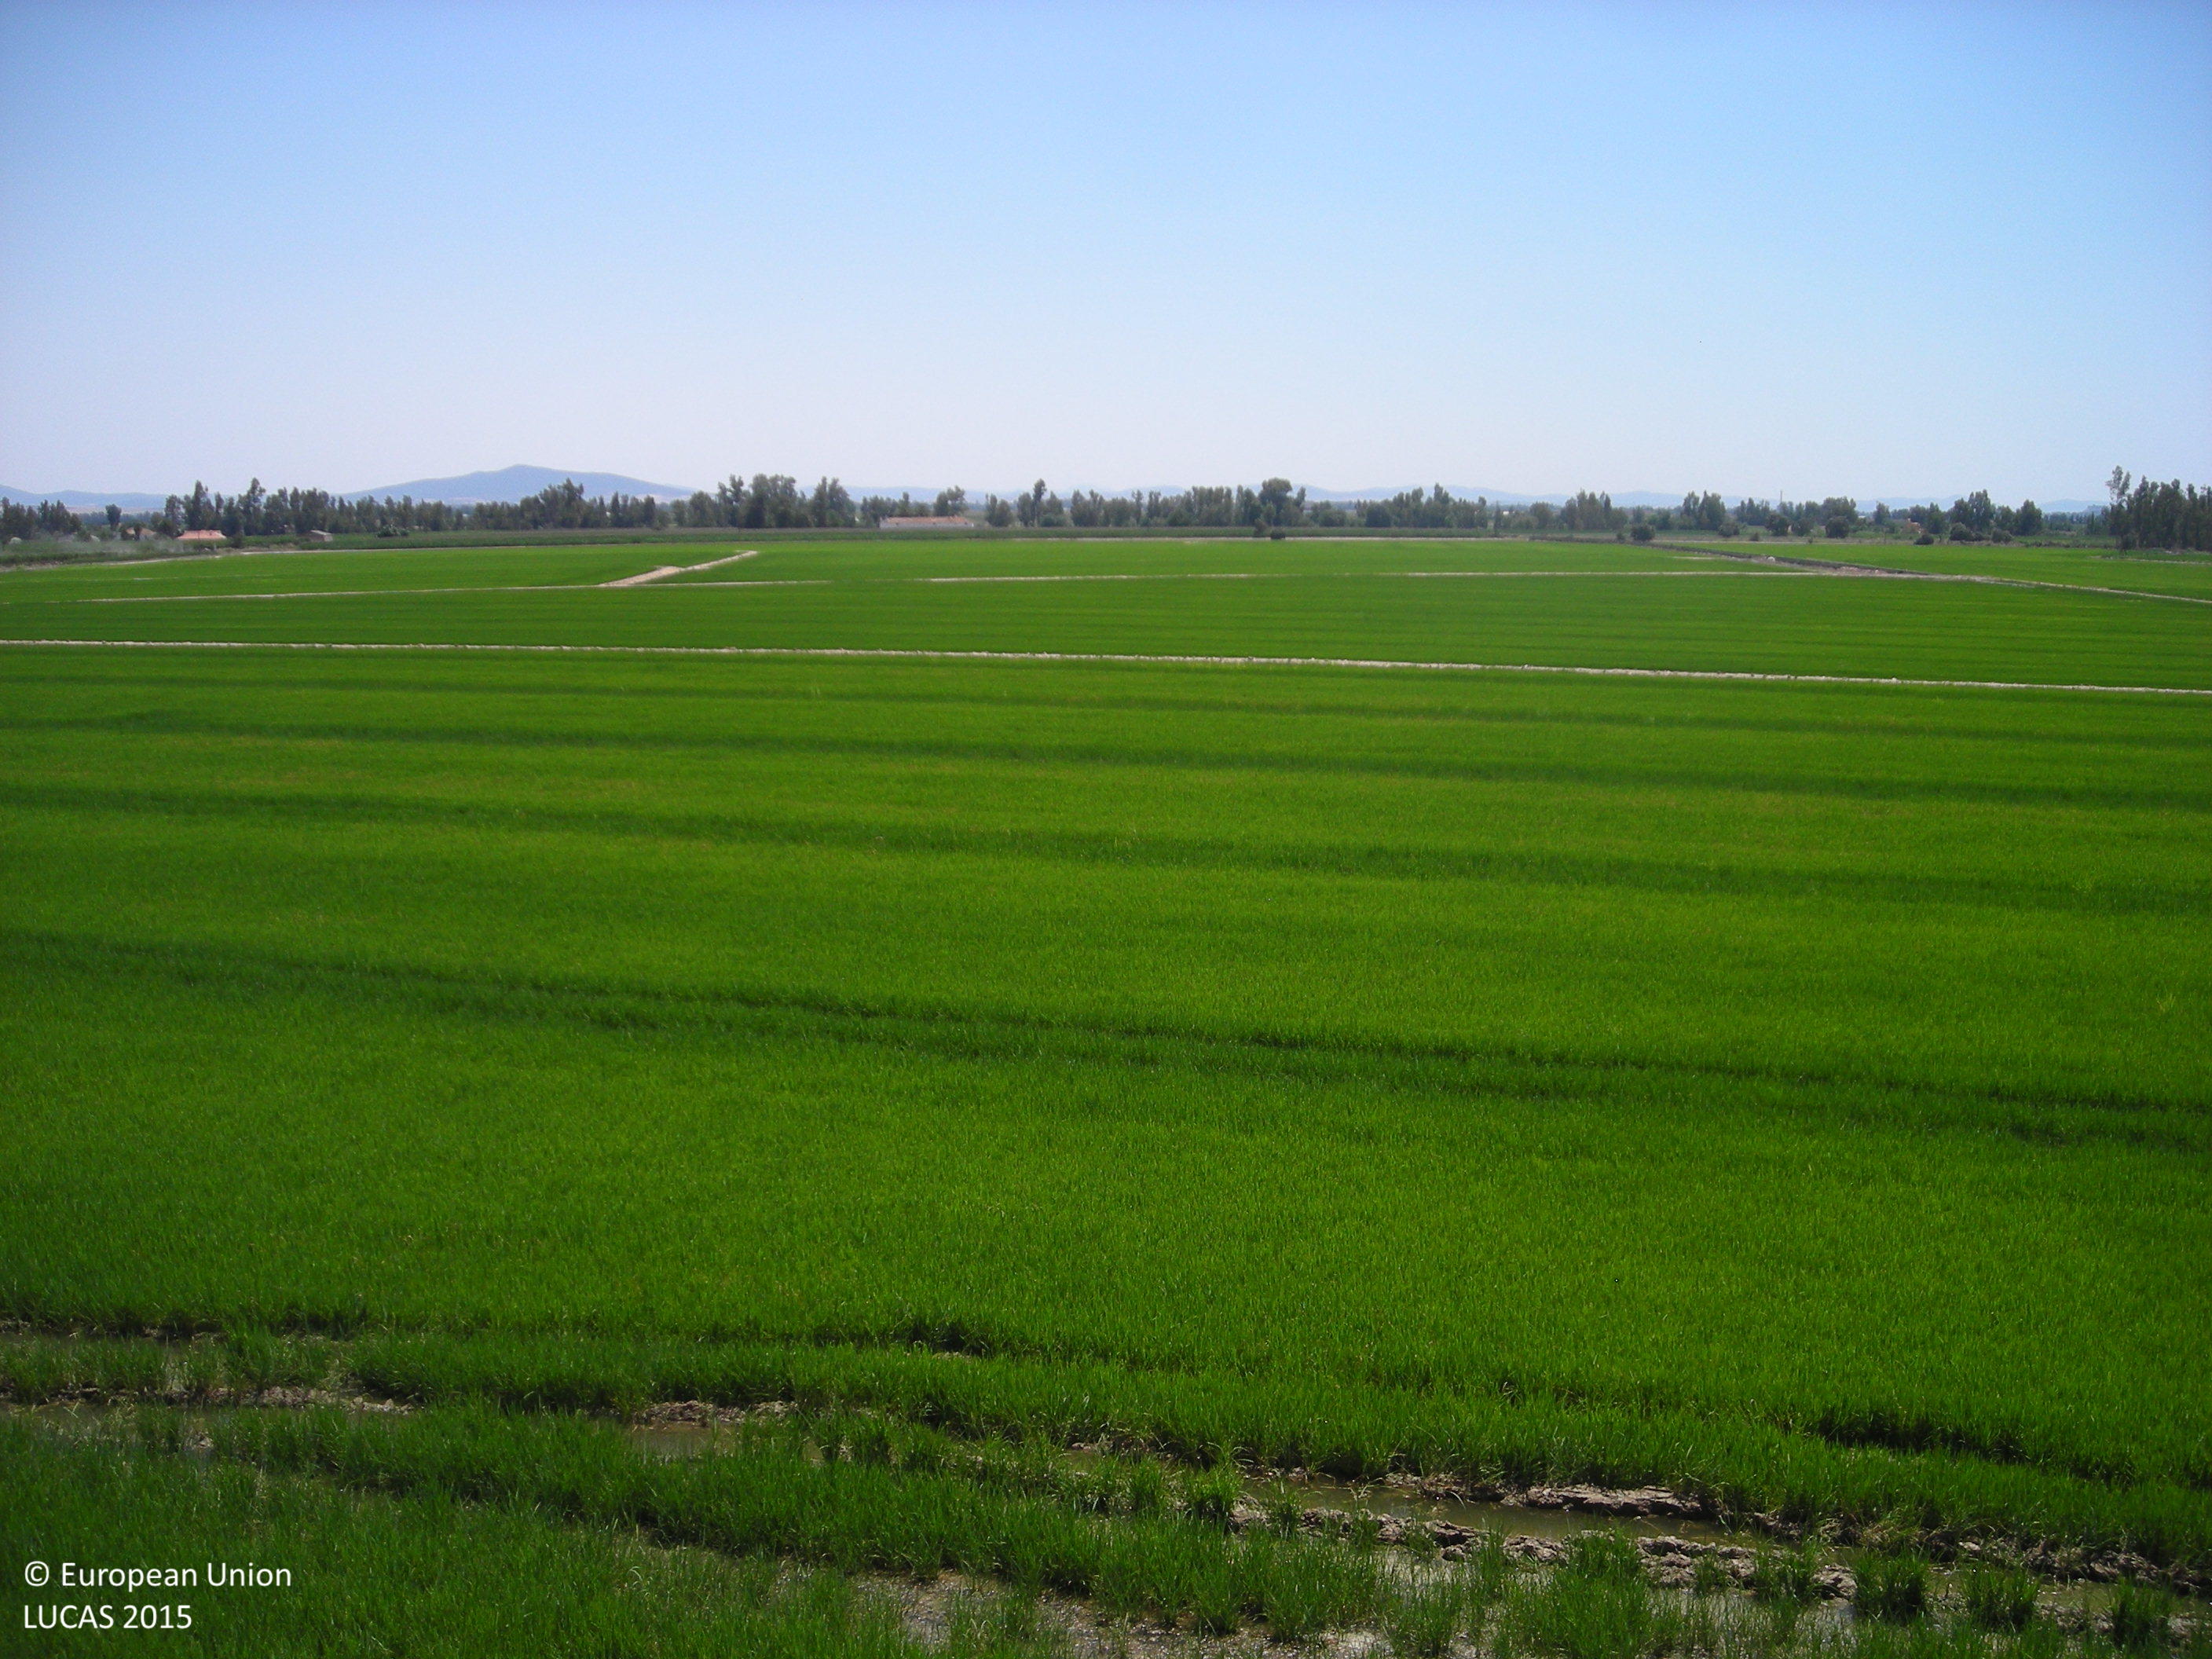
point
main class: Cropland
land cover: Rice
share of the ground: > 75 %
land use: Agriculture (excluding fallow land and kitchen gardens)
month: July
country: ES
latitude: 39.0618
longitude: -5.8490
